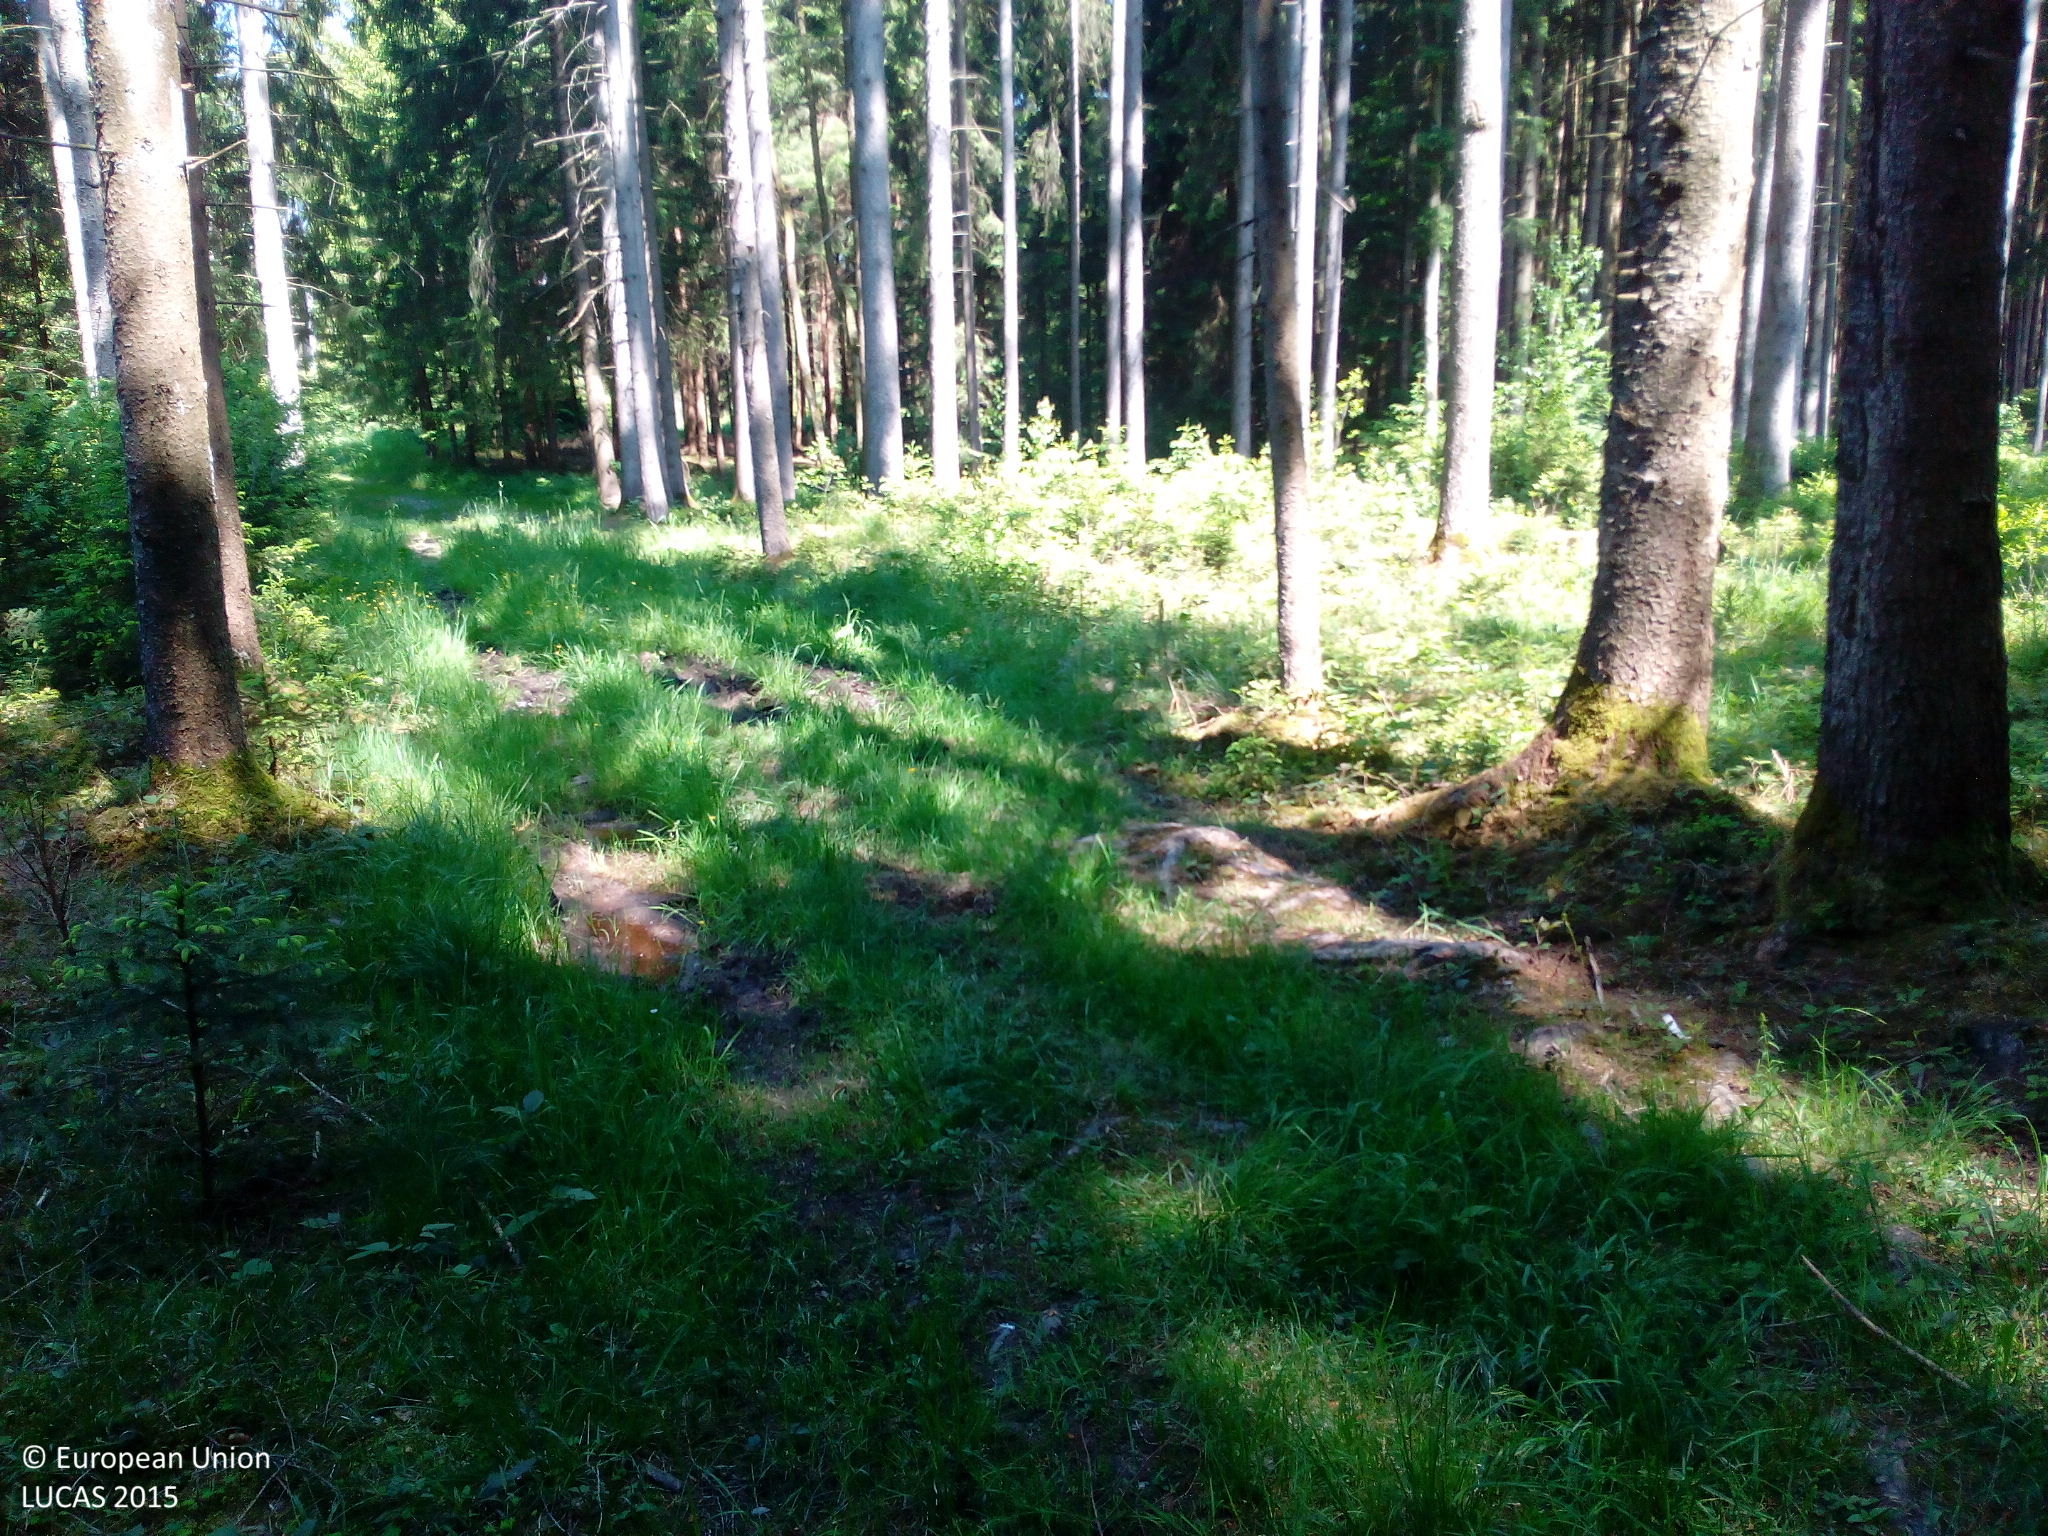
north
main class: Woodland
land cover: Spruce dominated coniferous woodland
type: hemiboreal forest and nemoral coniferous forest and mixed broadleaved-coniferous forest
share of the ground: > 75 %
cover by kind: coniferous forest trees 100 %
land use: Forestry
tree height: > 5 m
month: June
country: DE
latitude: 47.8093
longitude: 10.2535
